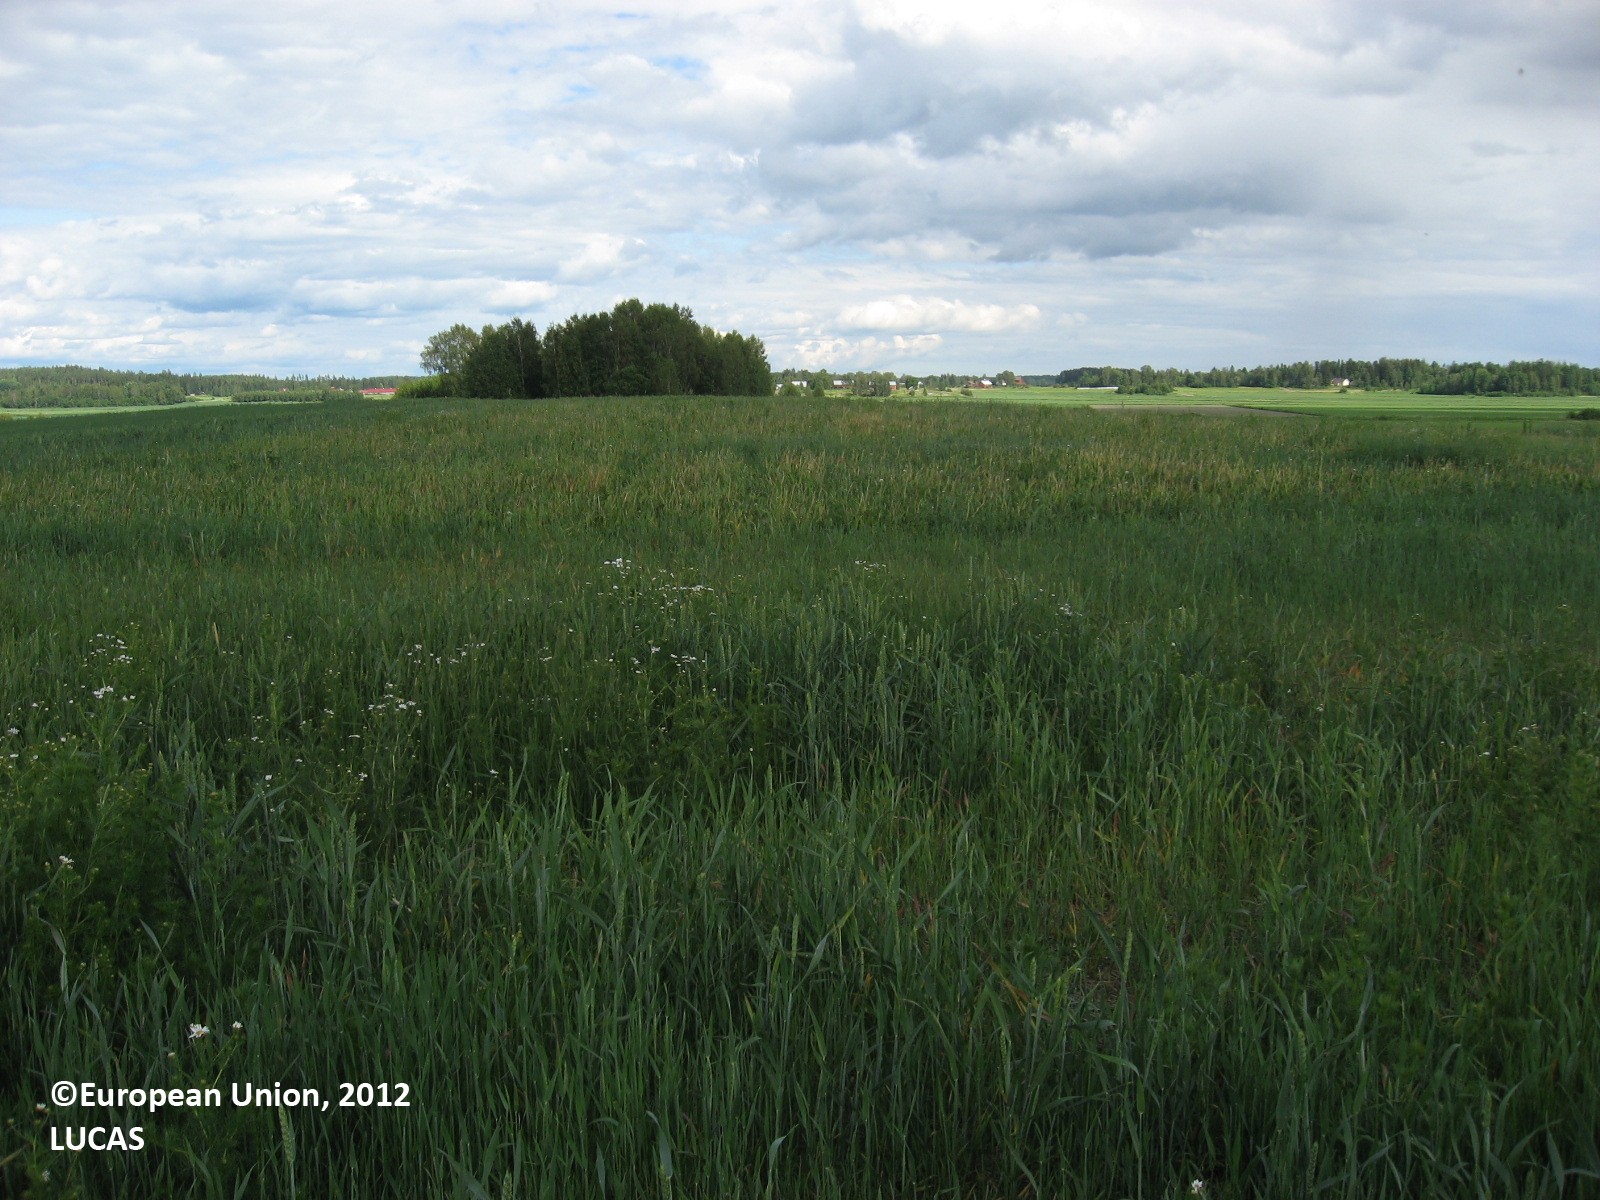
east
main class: Cropland
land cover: Common wheat
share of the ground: > 75 %
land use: Agriculture (excluding fallow land and kitchen gardens)
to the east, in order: Common wheat; Grass margins; Ditches and canals; Broadleaved woodland; Arable land (only in case pi)
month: June
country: FI
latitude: 60.7358
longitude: 26.4560
